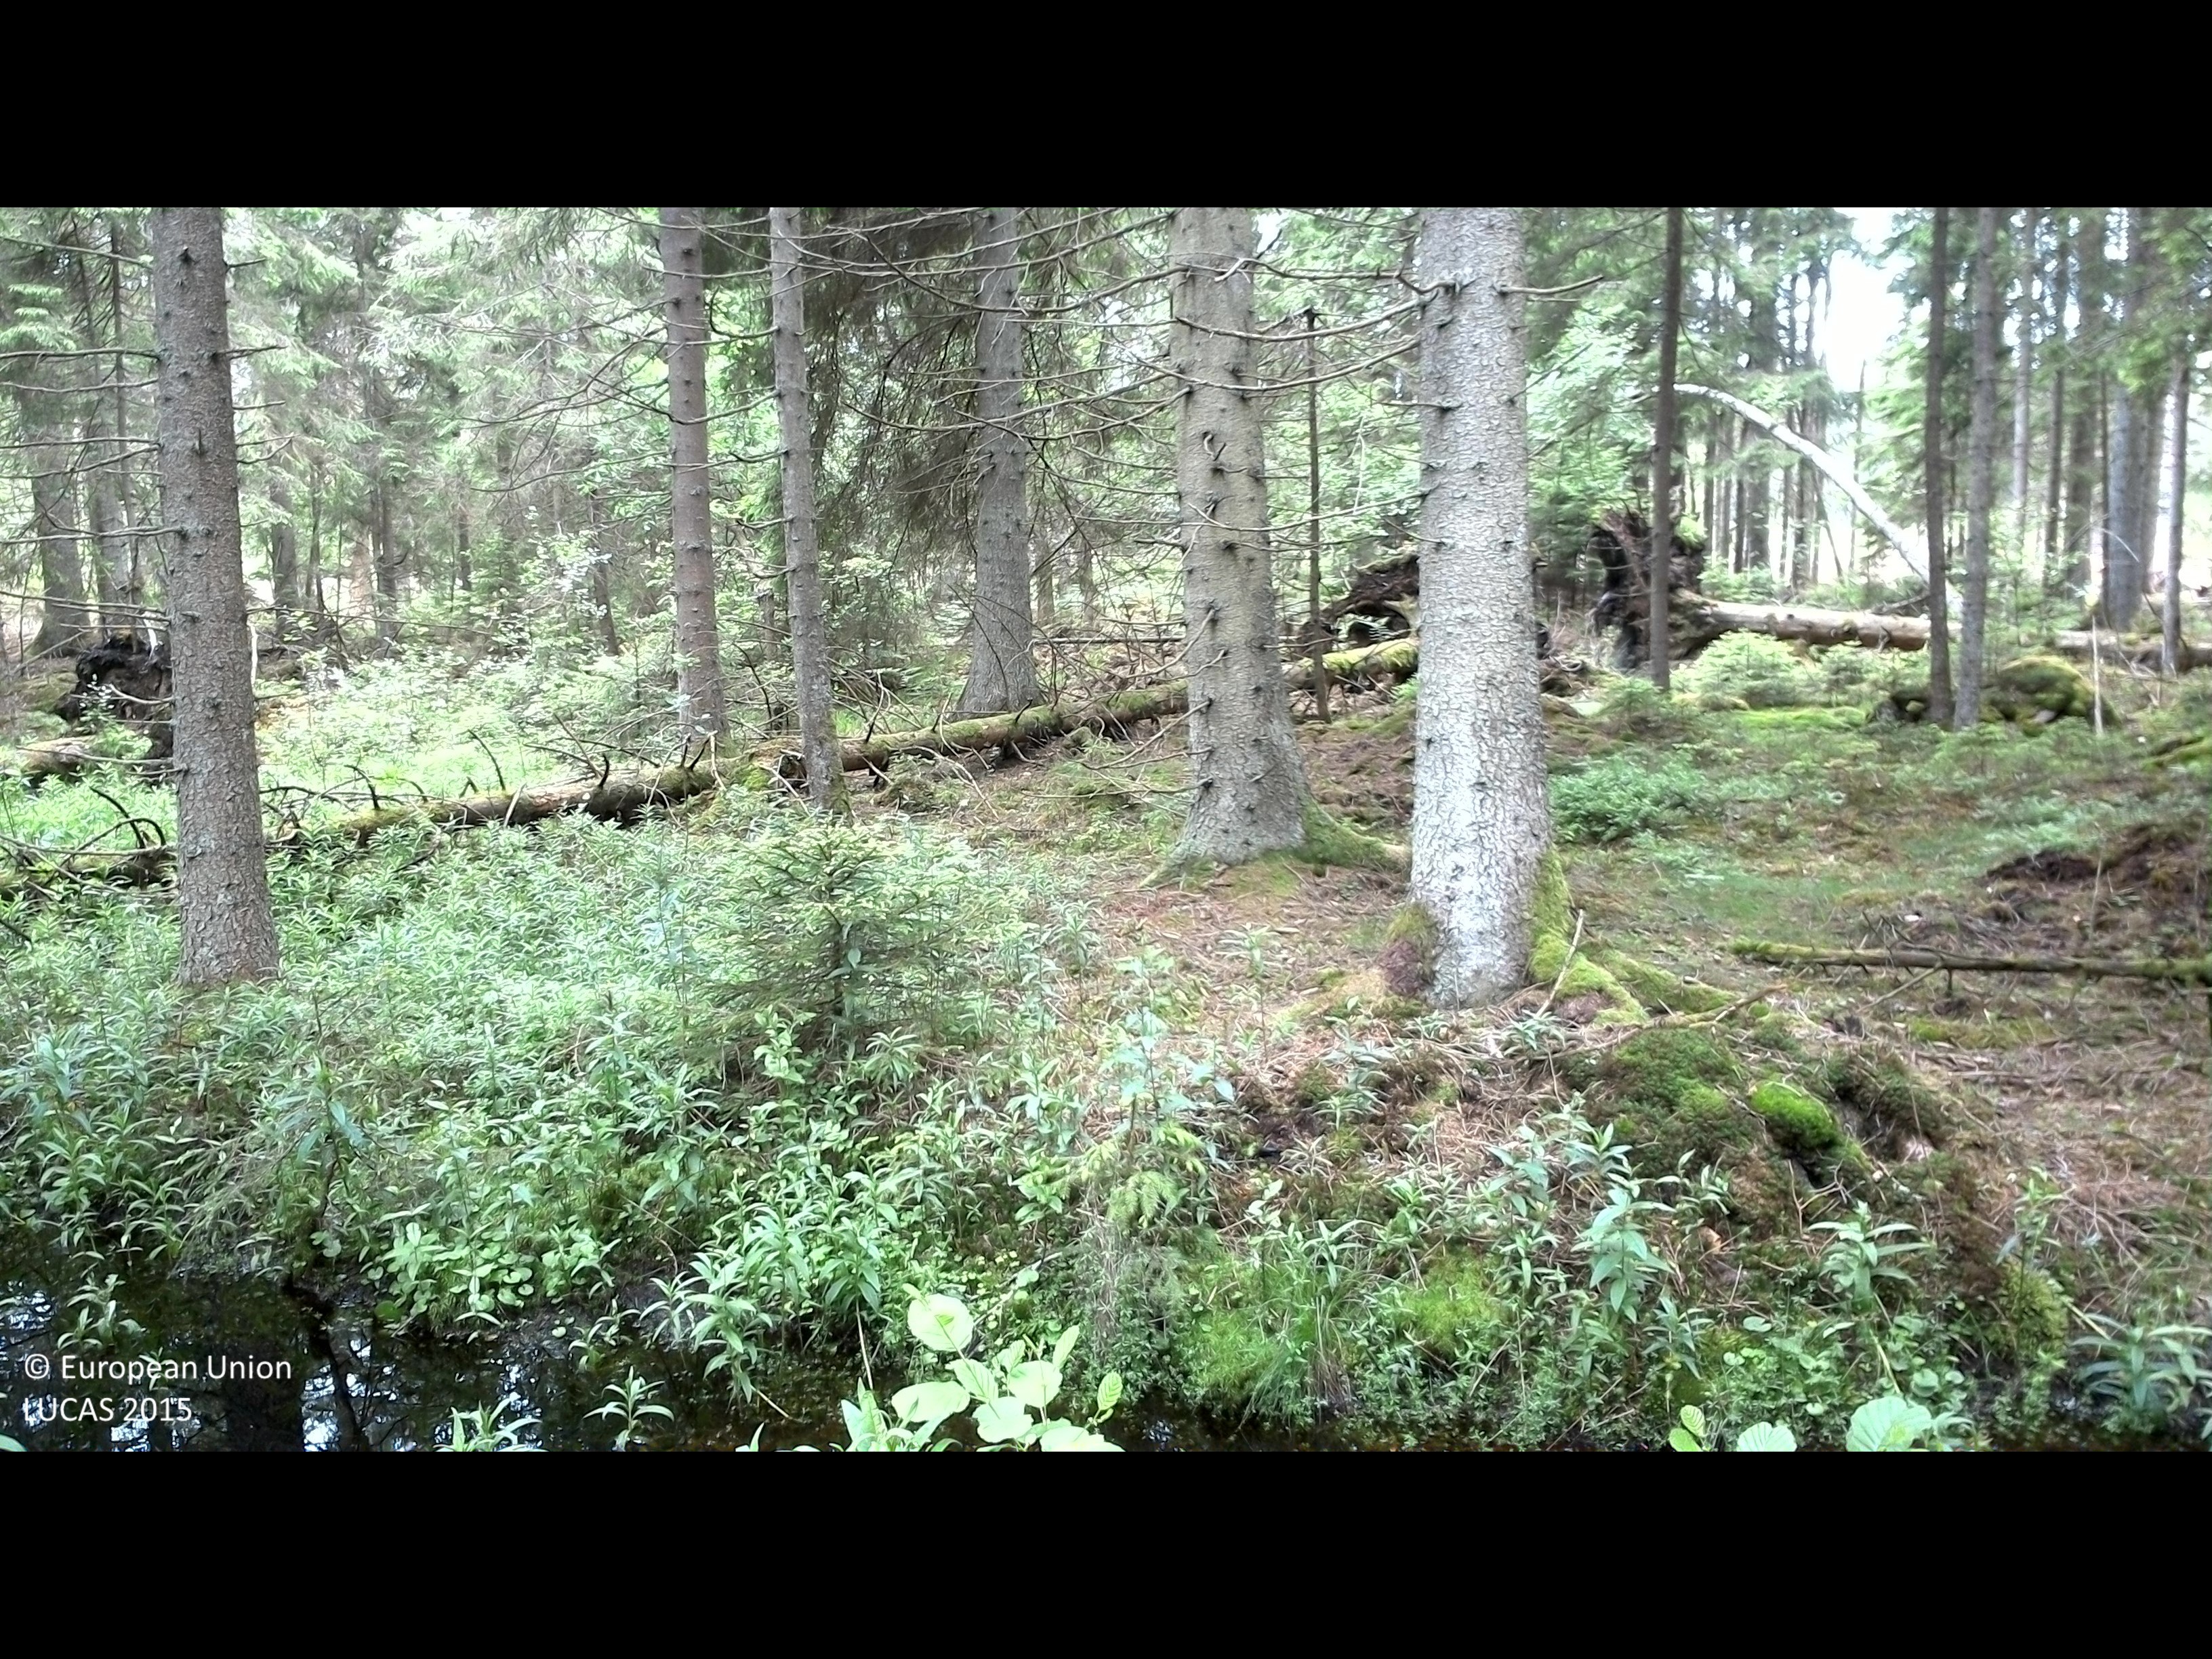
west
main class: Woodland
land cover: Spruce dominated coniferous woodland
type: boreal forest
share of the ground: 50 - 75 %
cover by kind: coniferous forest trees 65 %, herbaceous plants 15 %, lichens and mosses 15 %, broadleaved forest trees 5 %
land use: Forestry
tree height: > 5 m
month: June
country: SE
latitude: 56.5388
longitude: 15.9030
